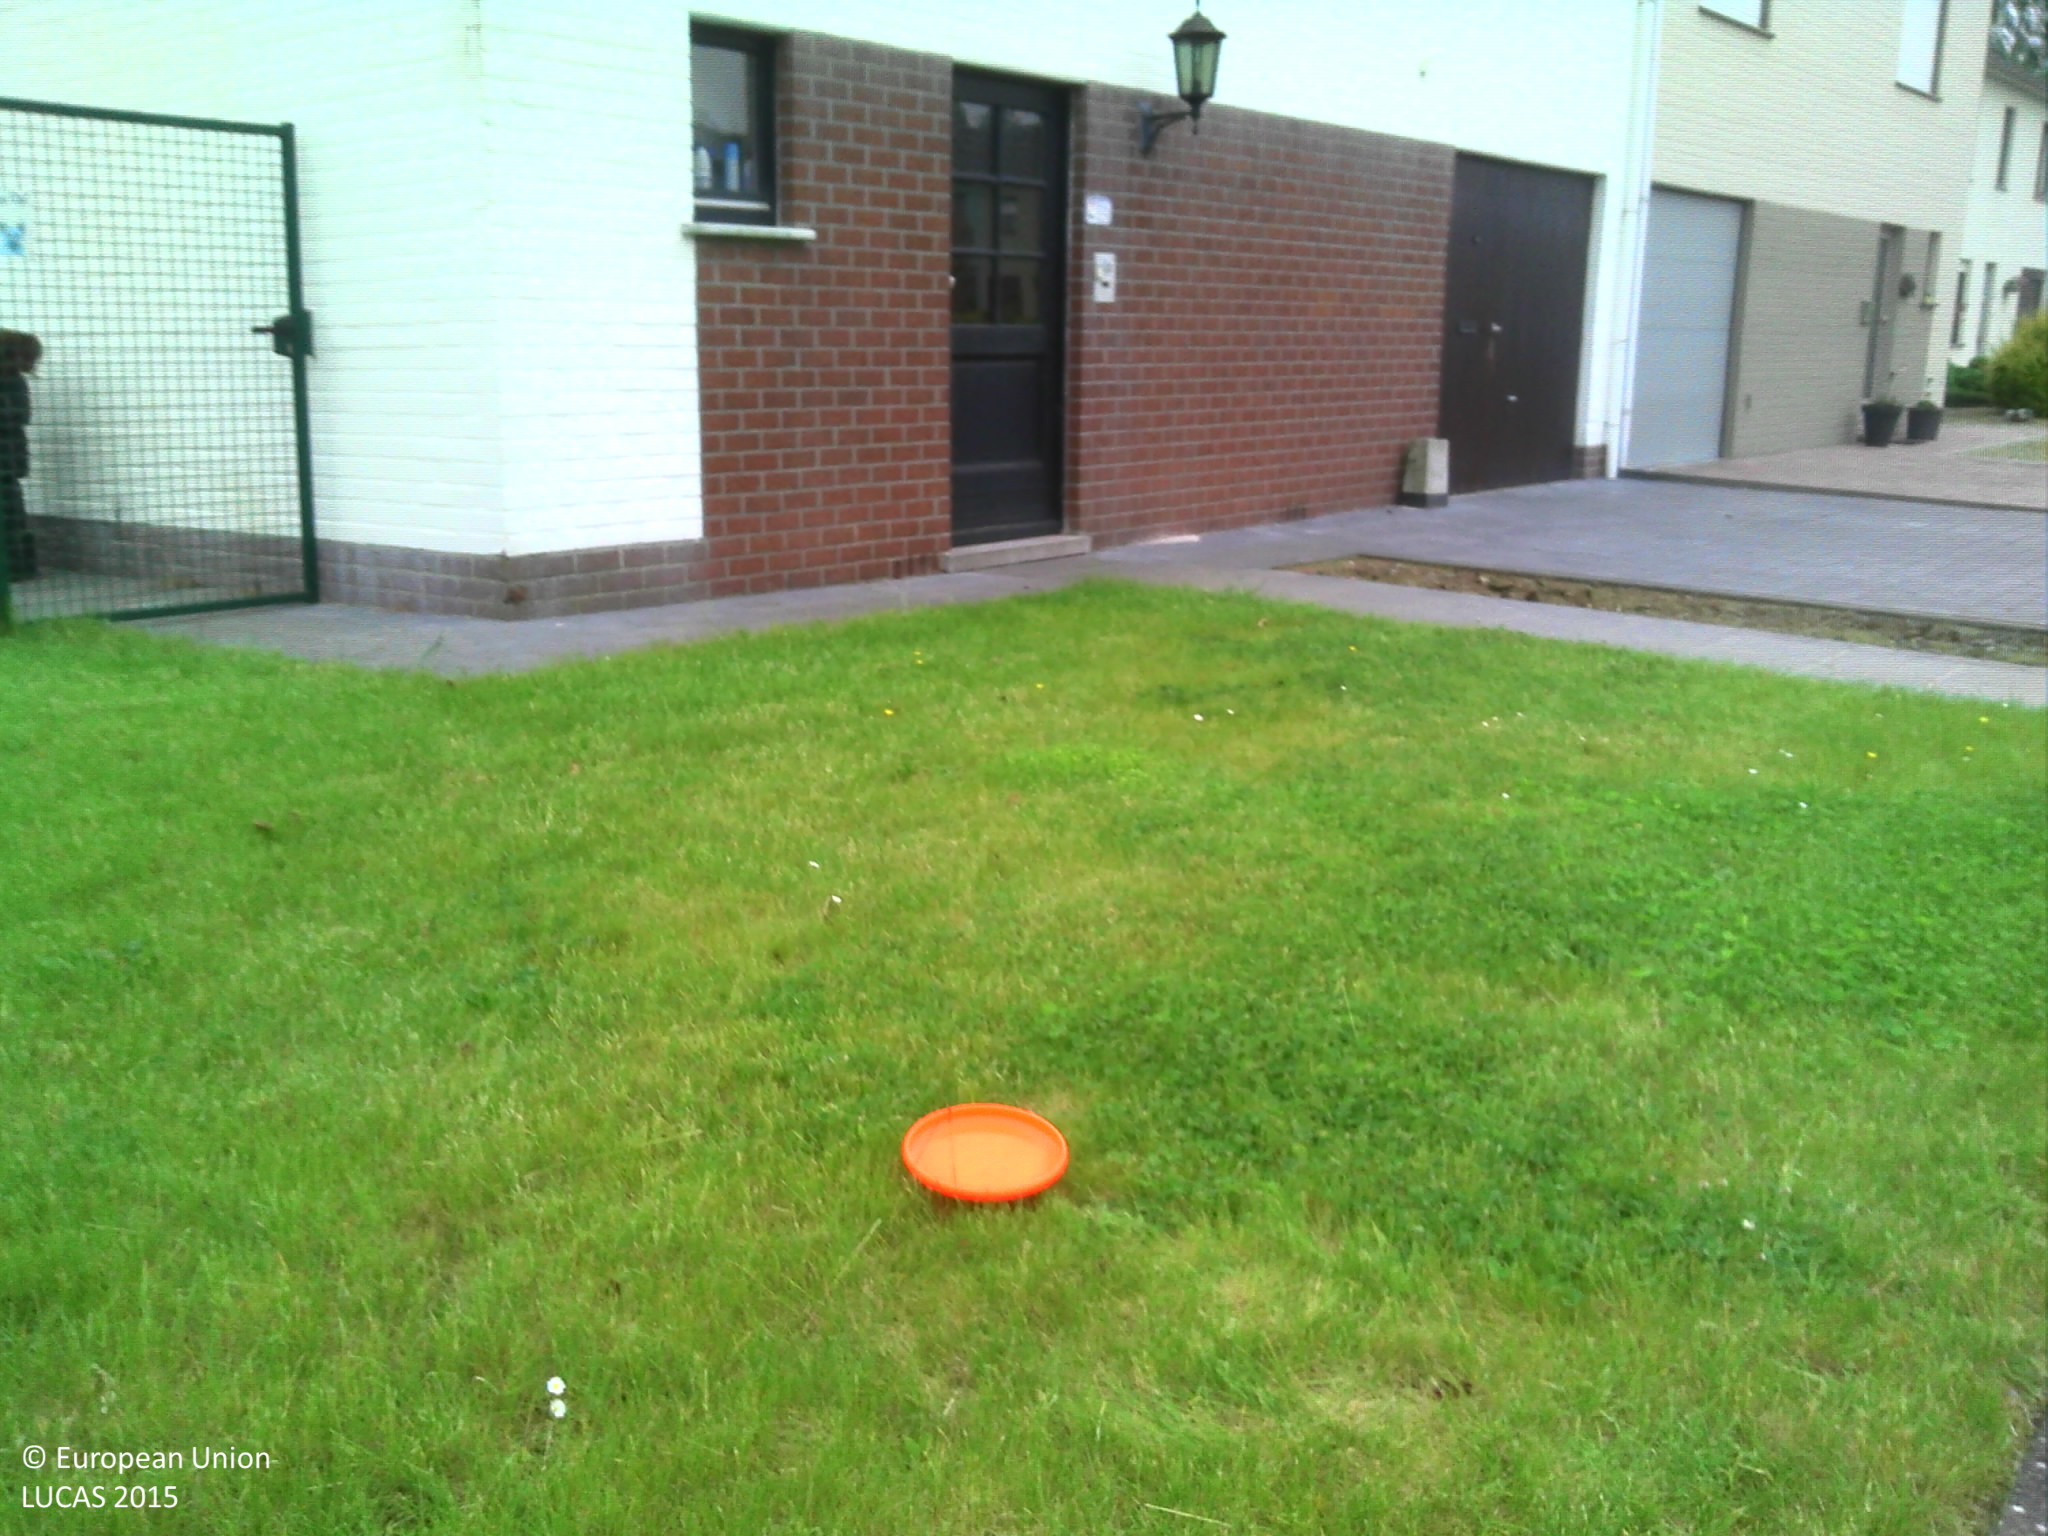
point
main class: Grassland
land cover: Grassland without tree/shrub cover
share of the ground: > 75 %
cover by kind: herbaceous plants 100 %
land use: Residential
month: June
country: BE
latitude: 50.8071
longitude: 3.7635
